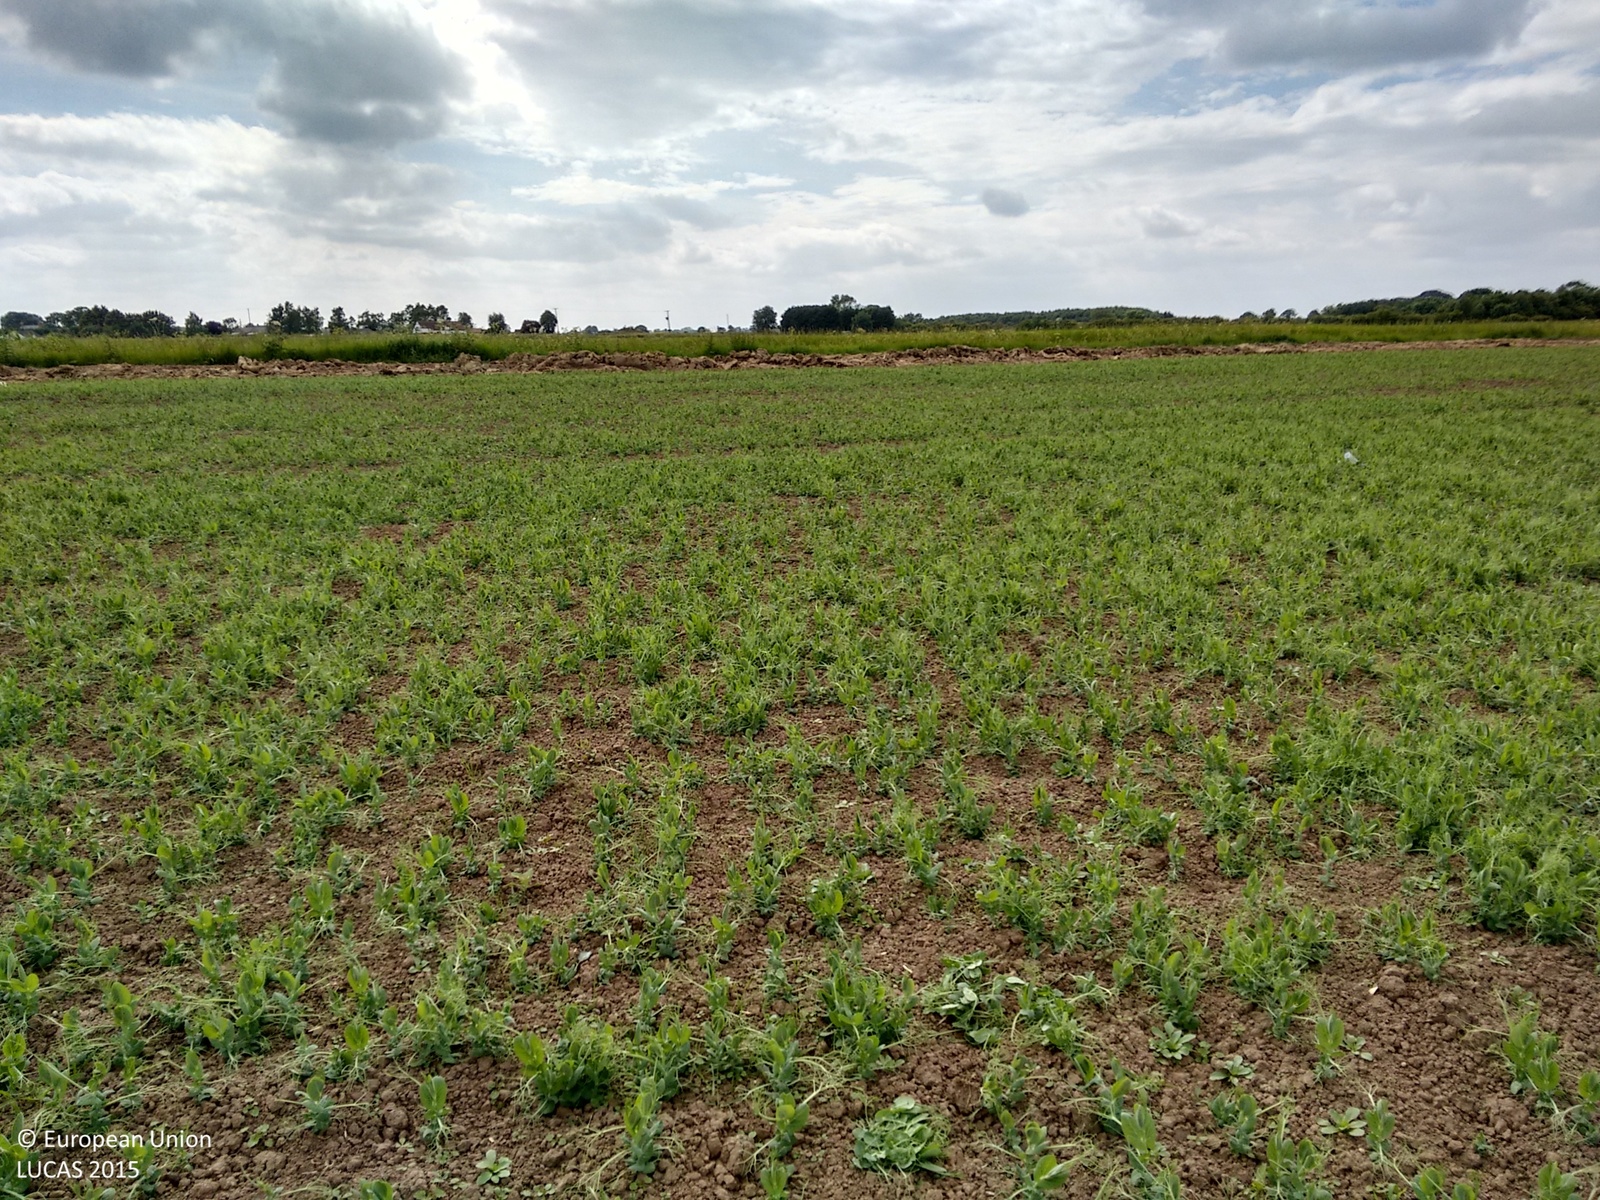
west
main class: Cropland
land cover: Dry pulses
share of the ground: 25 - 50 %
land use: Agriculture (excluding fallow land and kitchen gardens)
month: June
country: GB
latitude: 53.0178
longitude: -0.0651
